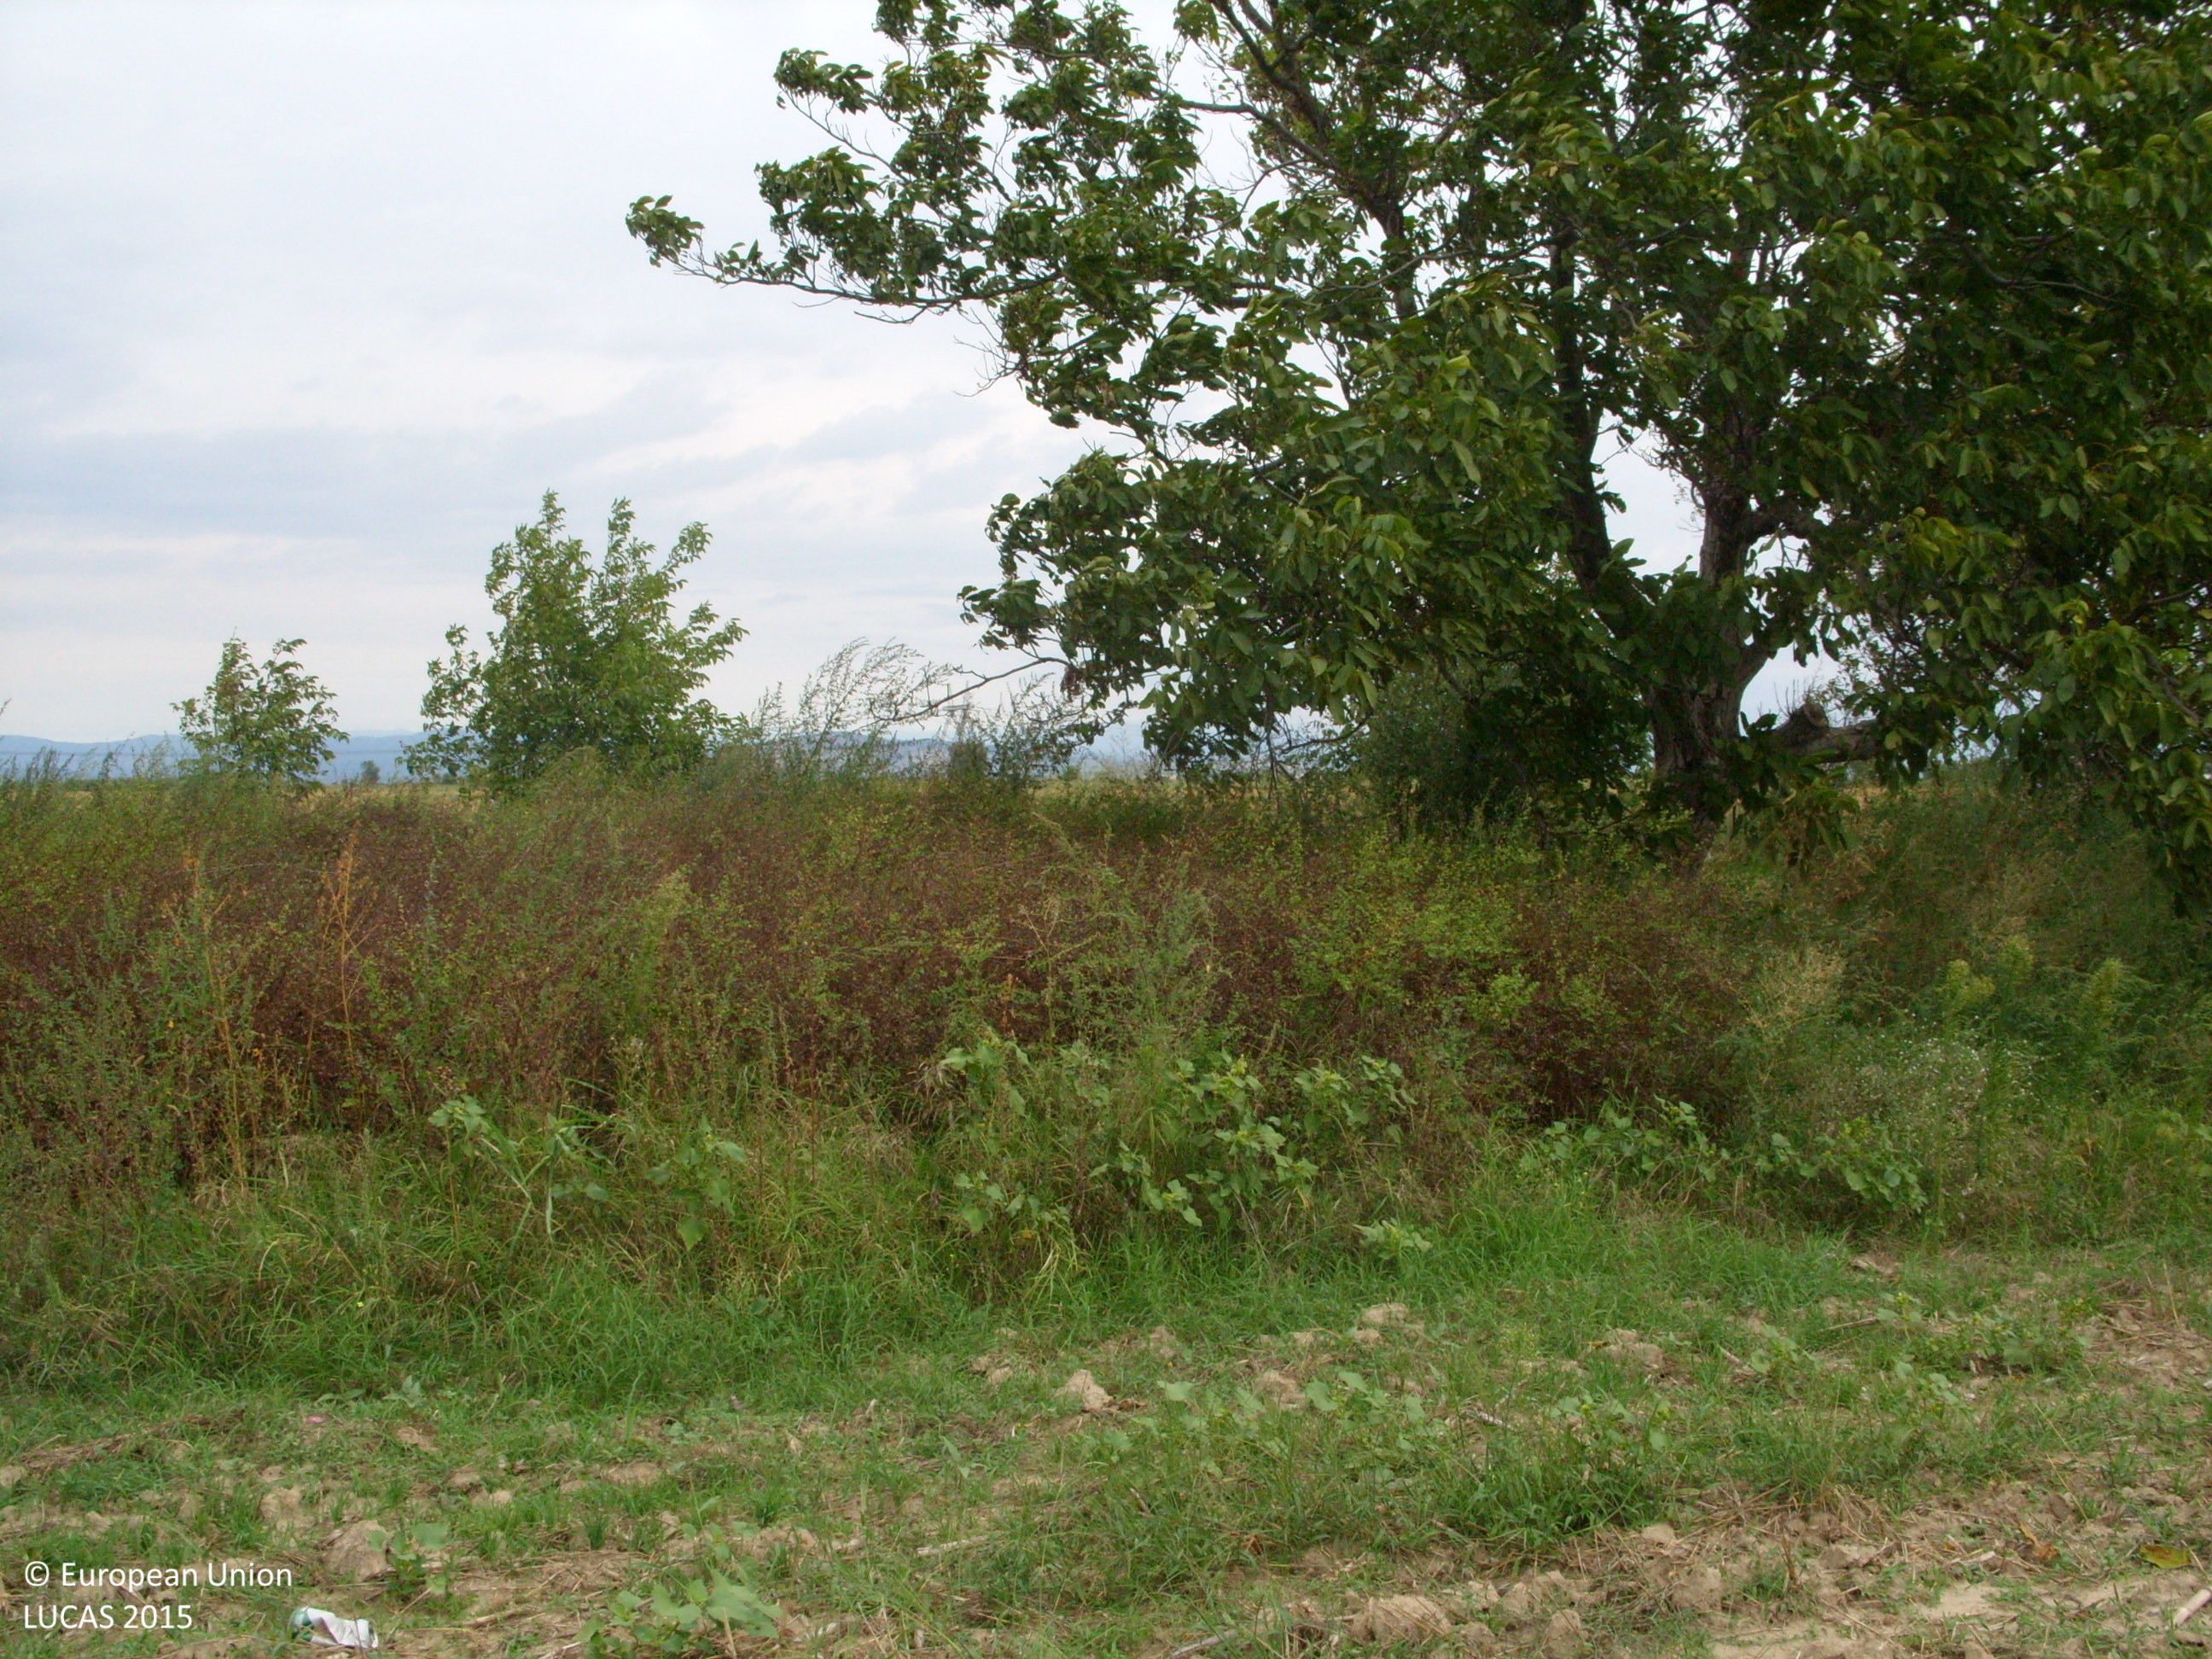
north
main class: Cropland
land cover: Common wheat
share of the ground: < 10 %
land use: Agriculture (excluding fallow land and kitchen gardens)
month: September
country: BG
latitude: 42.1617
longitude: 24.1910
